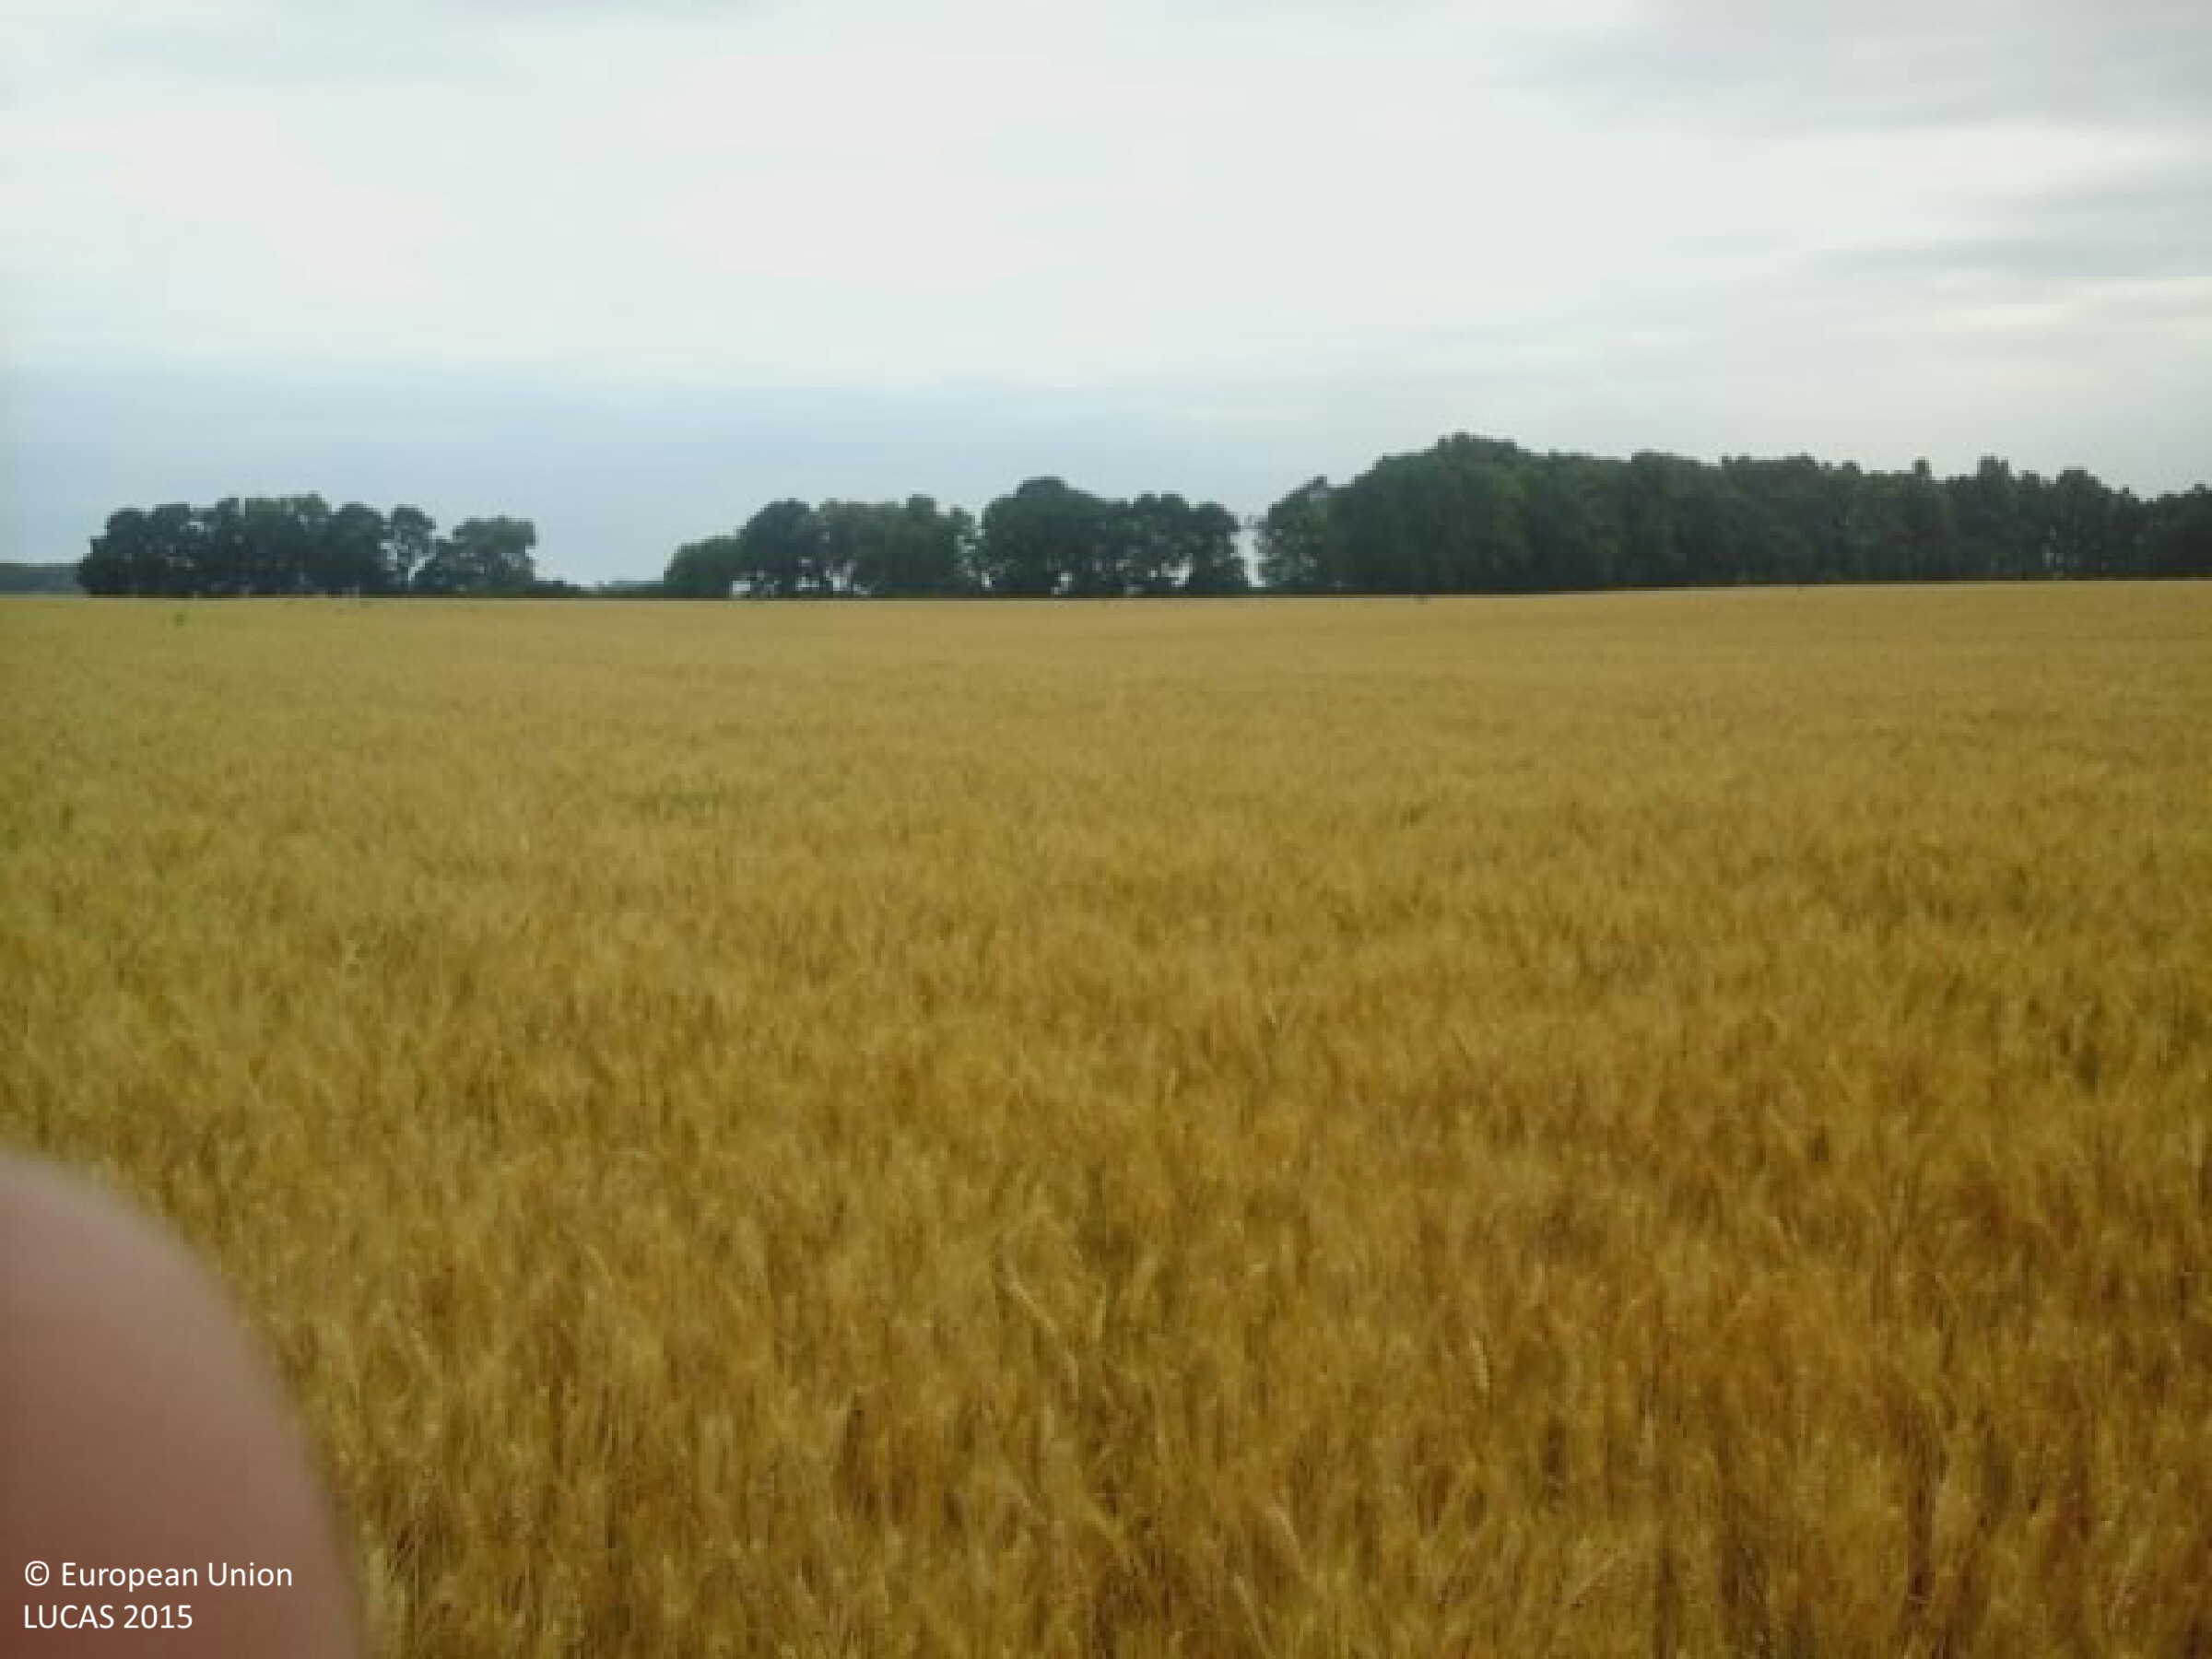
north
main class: Cropland
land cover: Common wheat
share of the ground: > 75 %
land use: Agriculture (excluding fallow land and kitchen gardens)
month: June
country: HU
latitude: 46.3409
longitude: 18.9122
